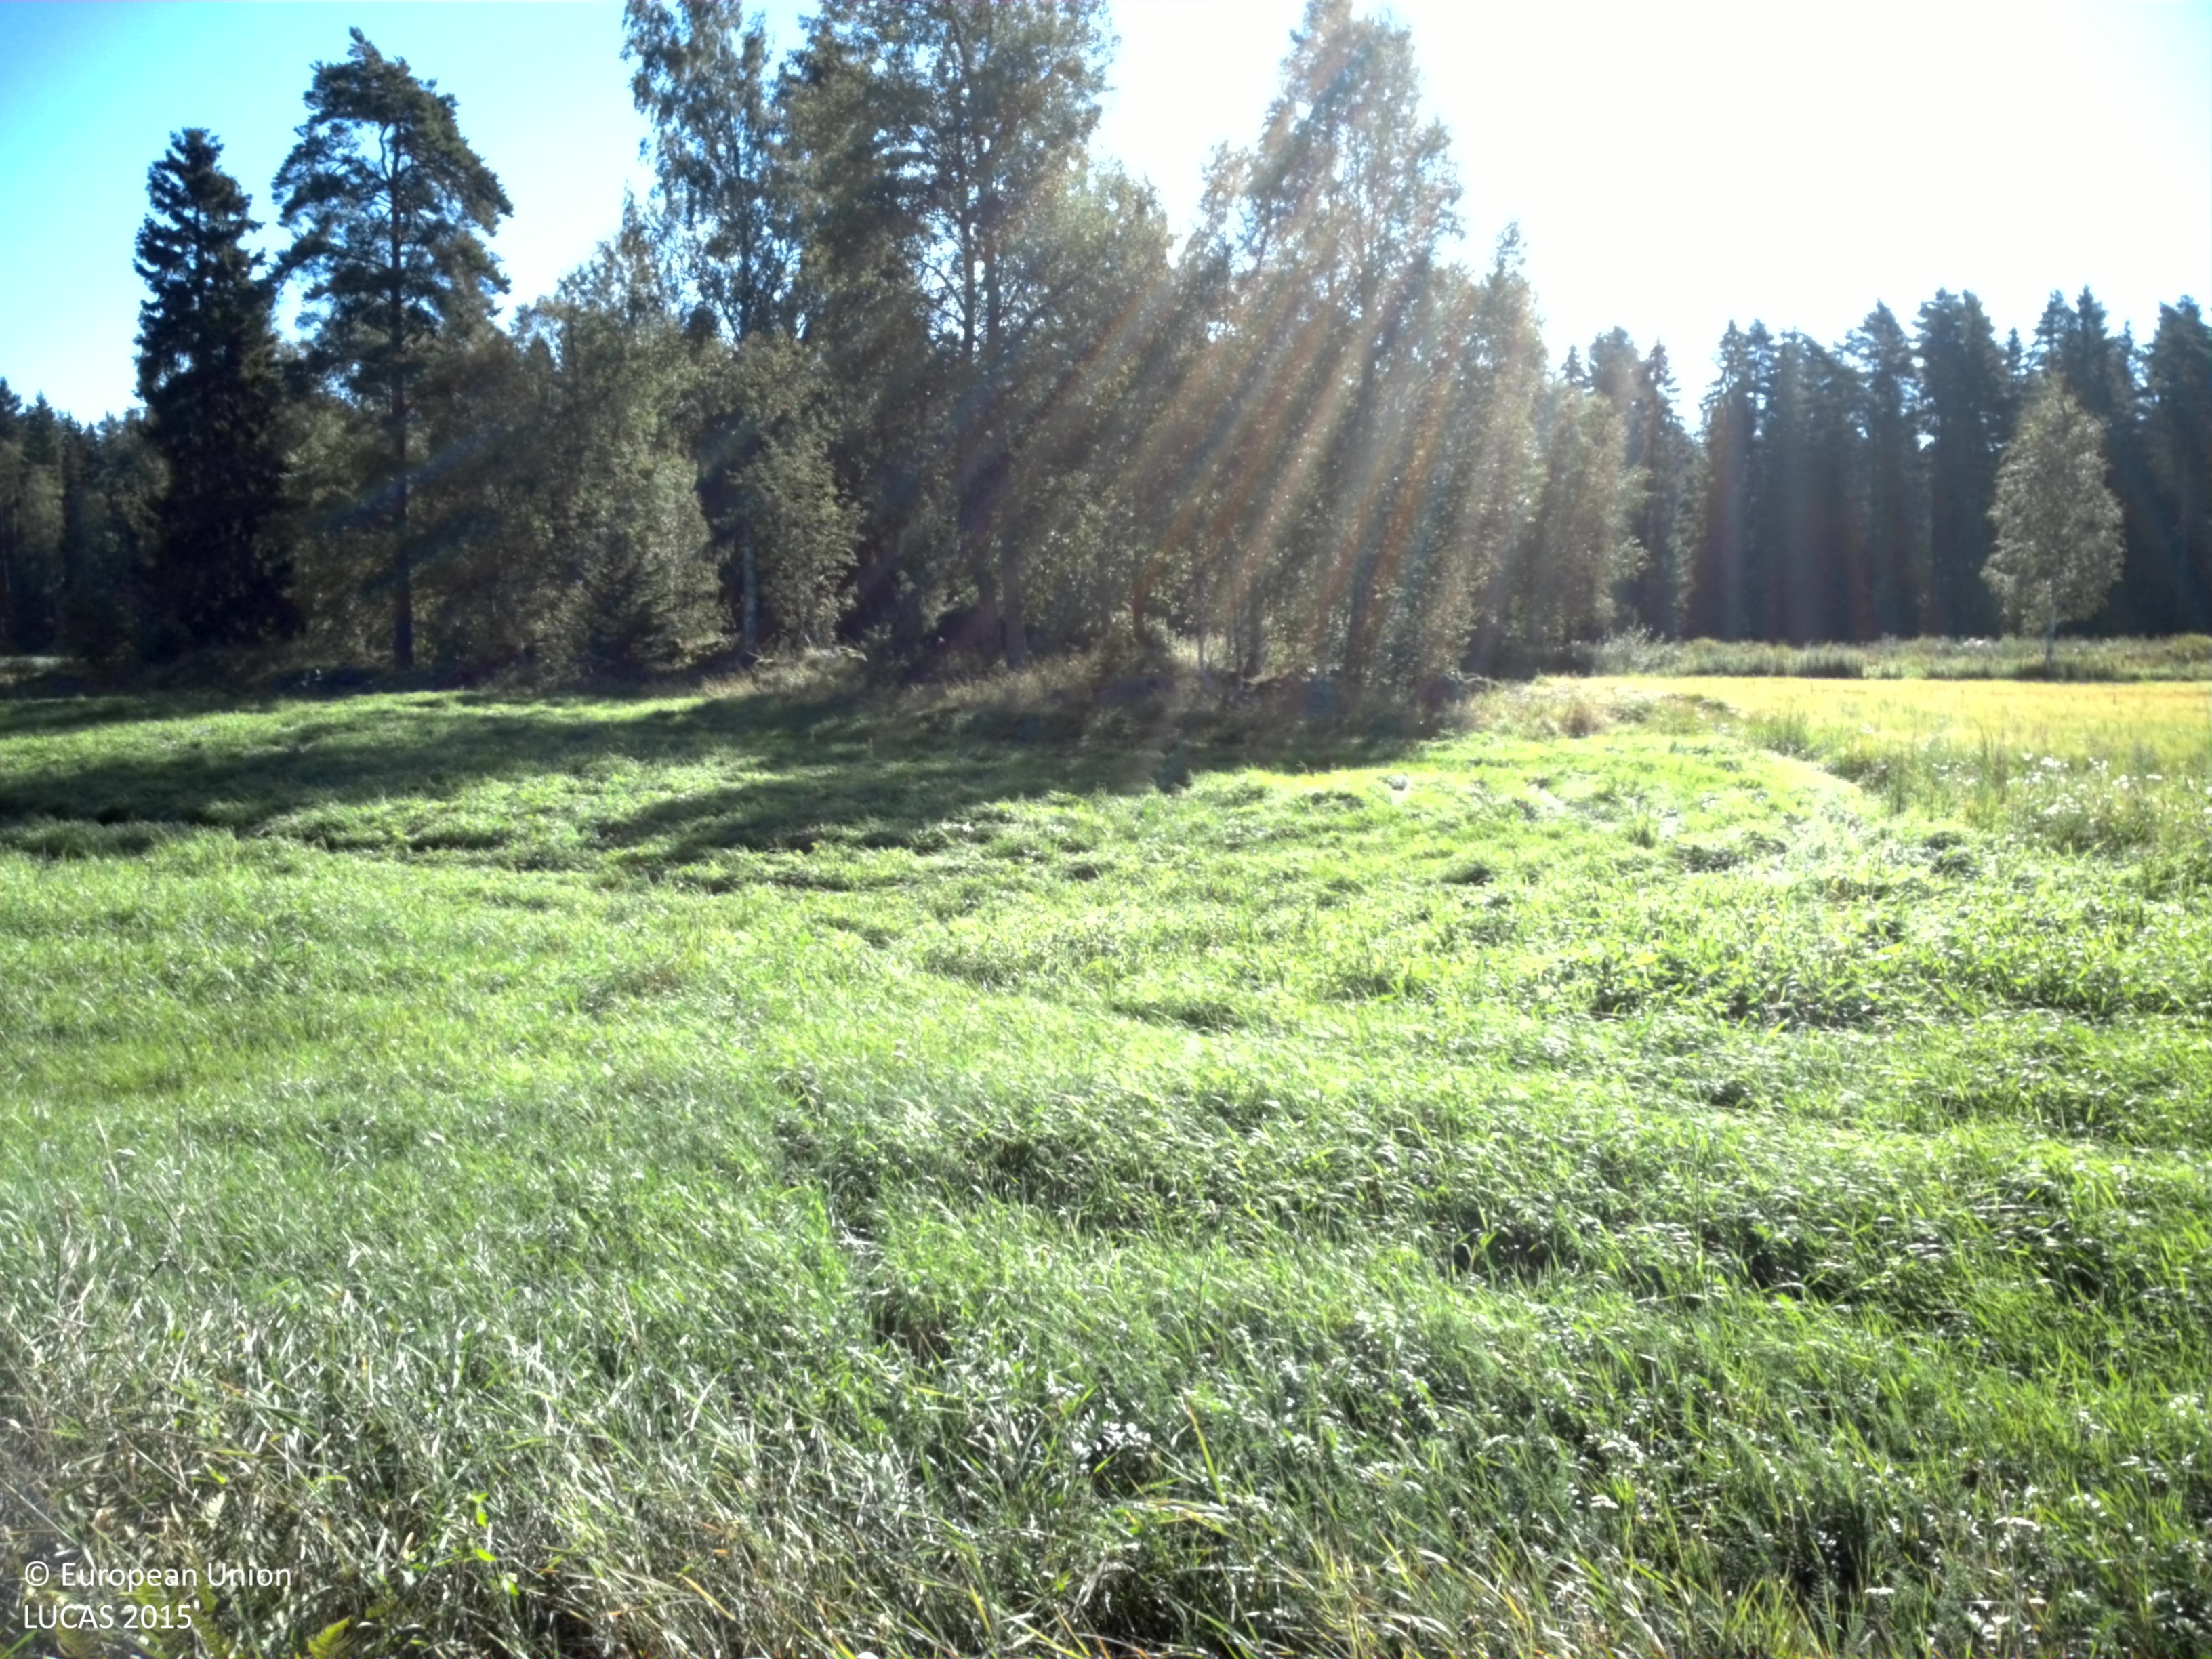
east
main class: Woodland
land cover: Broadleaved woodland
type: hemiboreal forest and nemoral coniferous forest and mixed broadleaved-coniferous forest
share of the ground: > 75 %
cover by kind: broadleaved forest trees 80 %, shrubs 15 %, coniferous forest trees 5 %
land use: Forestry
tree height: > 5 m
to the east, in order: Broadleaved woodland; Ditches and canals; Tracks; Other leguminous and mixtures for fodder; Dry stone walls; Broadleaved woodland; Other leguminous and mixtures for fodder; Ditches and canals; Other leguminous and mixtures for fodder; Other coniferous woodland; Spruce dominated coniferous woodland; Tracks; Oats
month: August
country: SE
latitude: 60.0621
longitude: 16.9793
